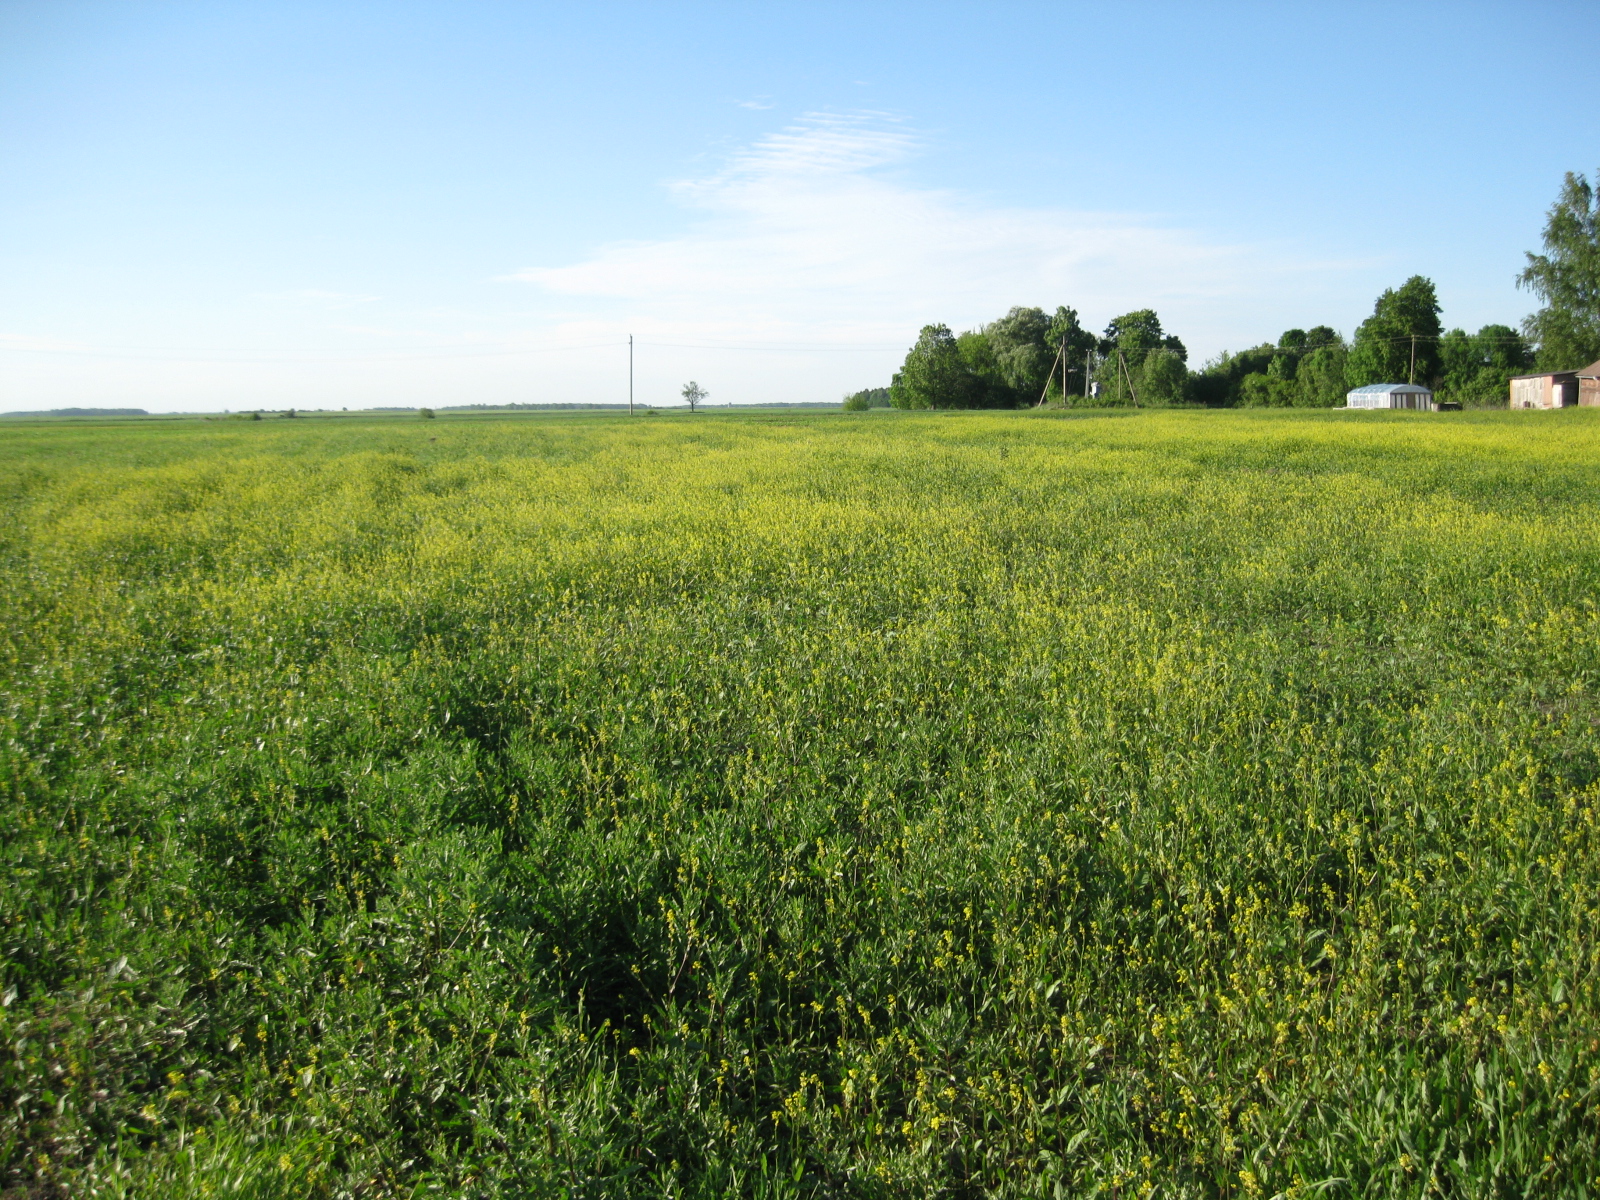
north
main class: Cropland
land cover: Rape and turnip rape
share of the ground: > 75 %
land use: Agriculture (excluding fallow land and kitchen gardens)
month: June
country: LT
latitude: 55.8043
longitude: 23.9511
